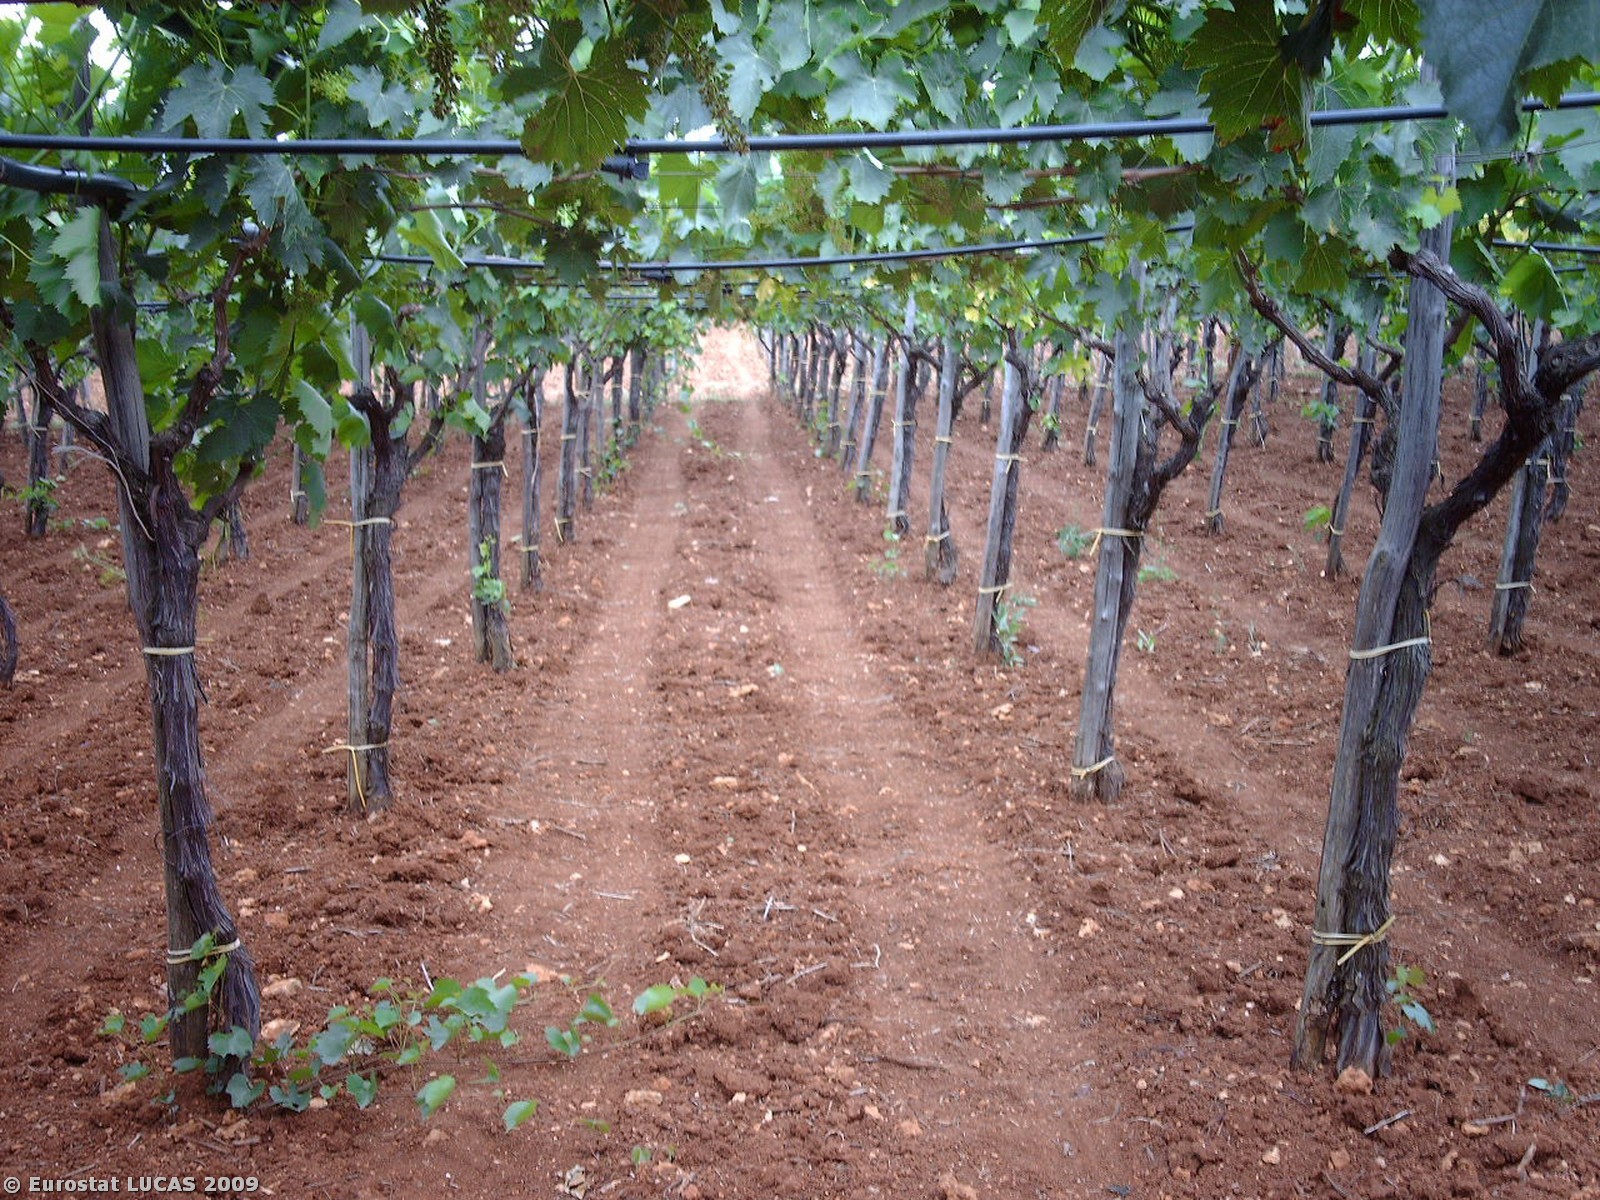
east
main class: Cropland
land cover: Vineyards
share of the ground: > 75 %
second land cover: Bare land
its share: 50 - 75 %
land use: Agriculture (excluding fallow land and kitchen gardens)
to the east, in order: Vineyards; Bare land; Vineyards; Spontaneously vegetated surfaces
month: June
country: IT
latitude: 40.9430
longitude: 16.9984
